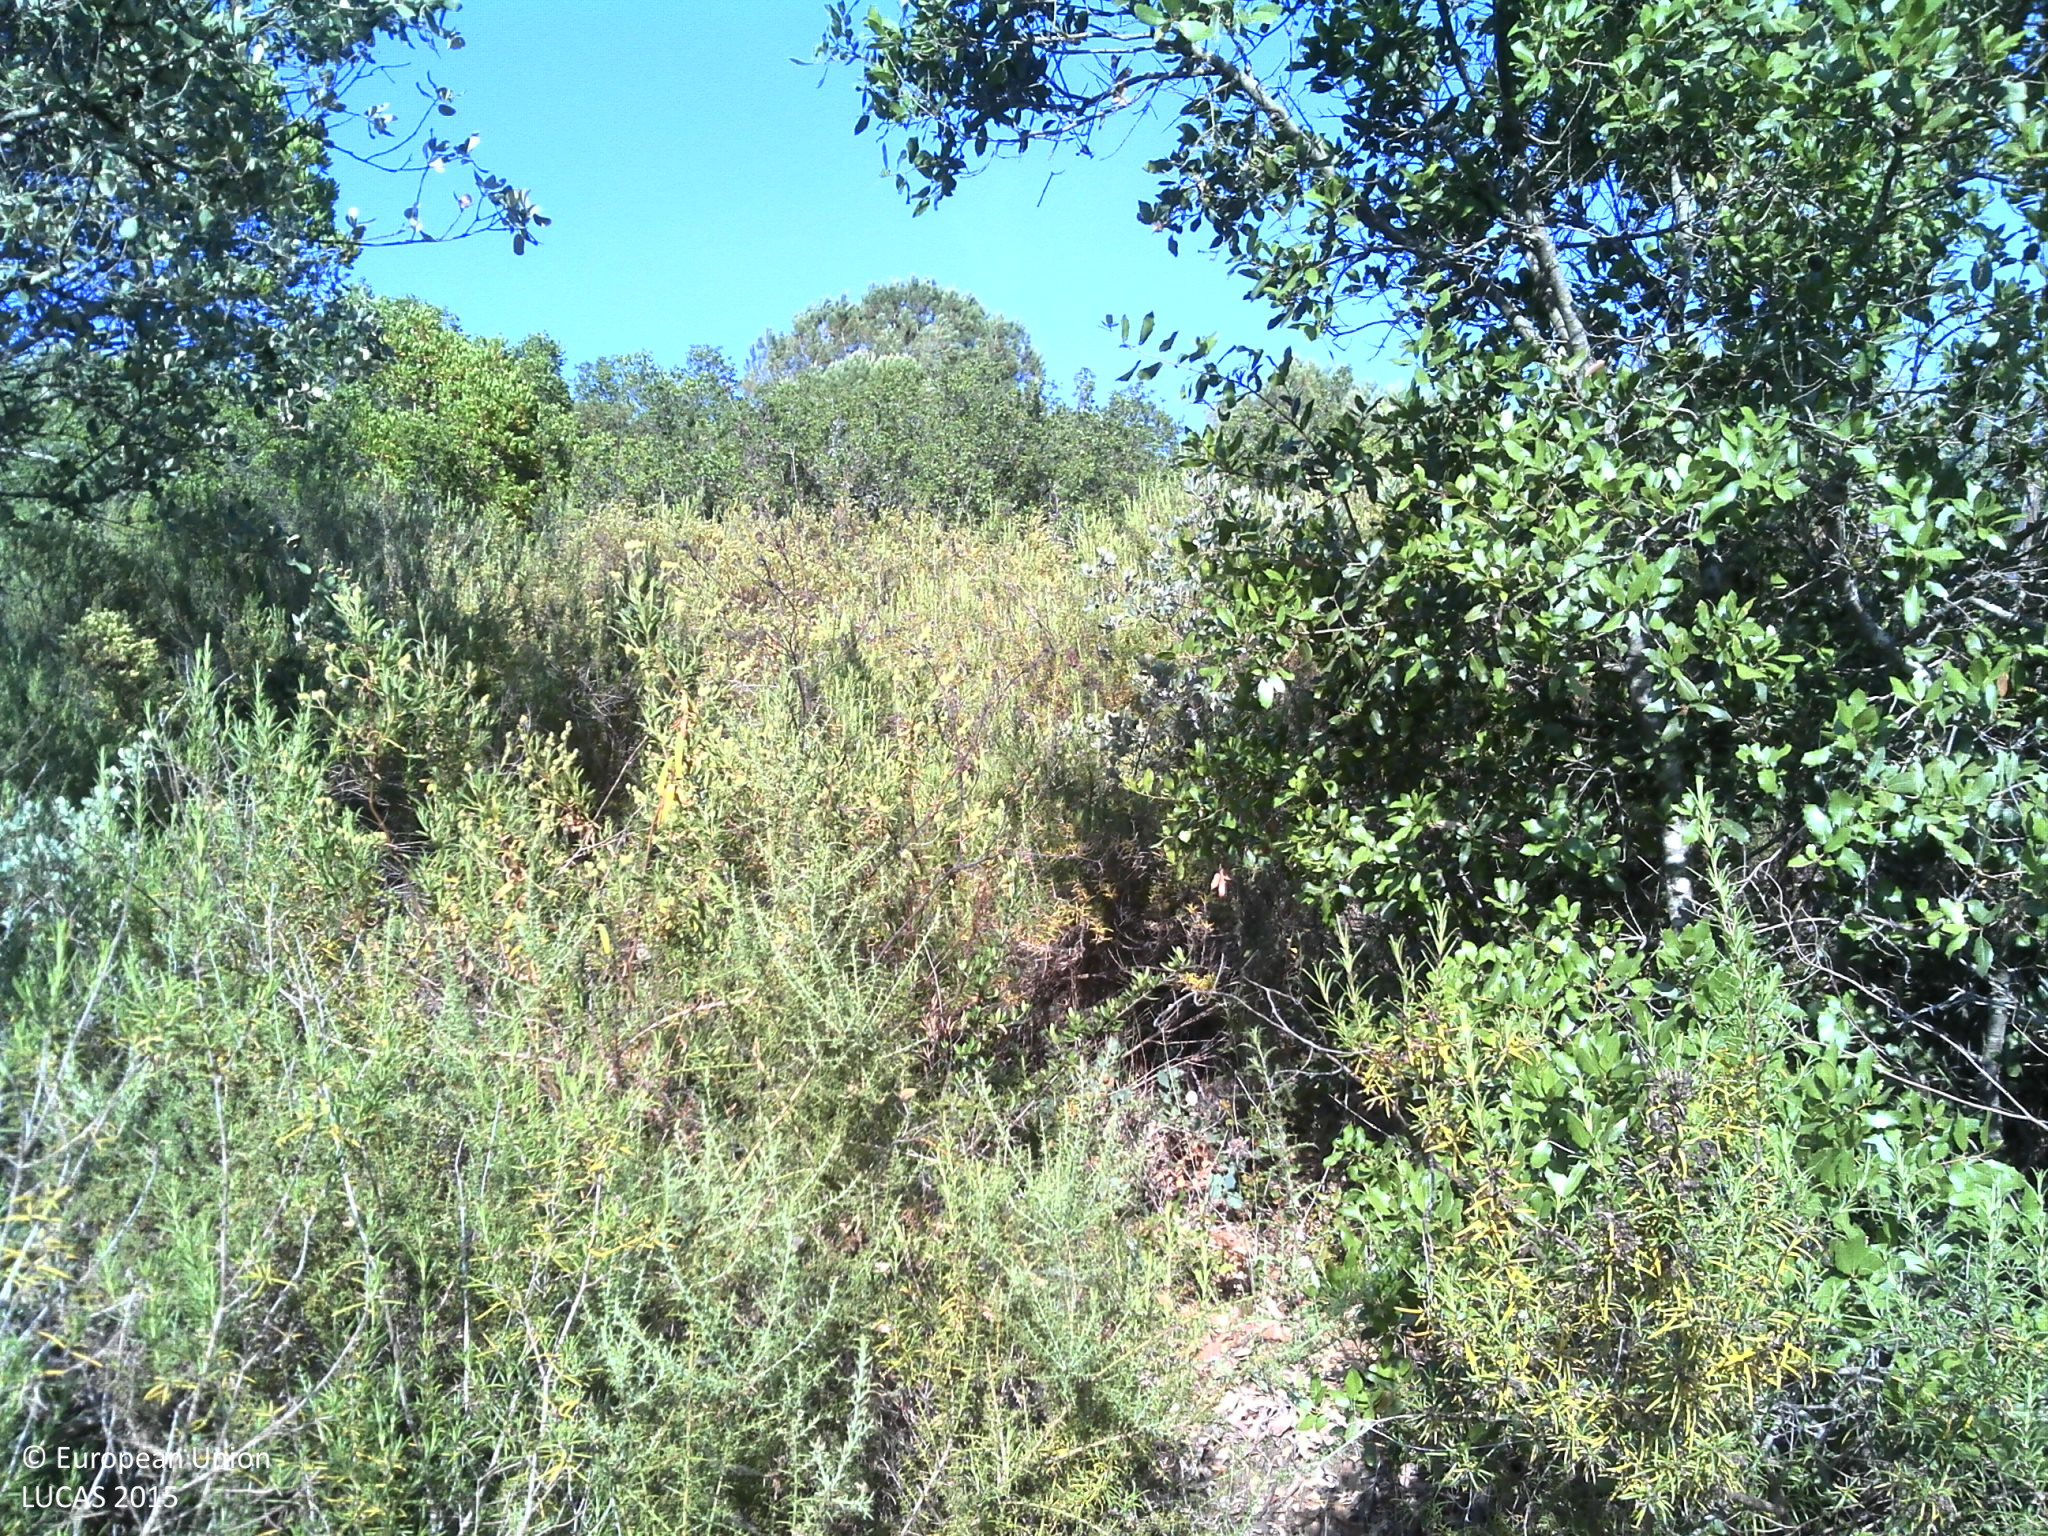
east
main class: Woodland
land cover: Broadleaved woodland
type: broadleaved evergreen forest
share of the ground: 25 - 50 %
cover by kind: shrubs 50 %, broadleaved forest trees 30 %, unconsolidated bare surface 15 %, coniferous forest trees 5 %
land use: Forestry
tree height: > 5 m
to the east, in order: Broadleaved woodland; Pine dominated coniferous woodland; Broadleaved woodland
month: May
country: PT
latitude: 38.1045
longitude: -8.3917
